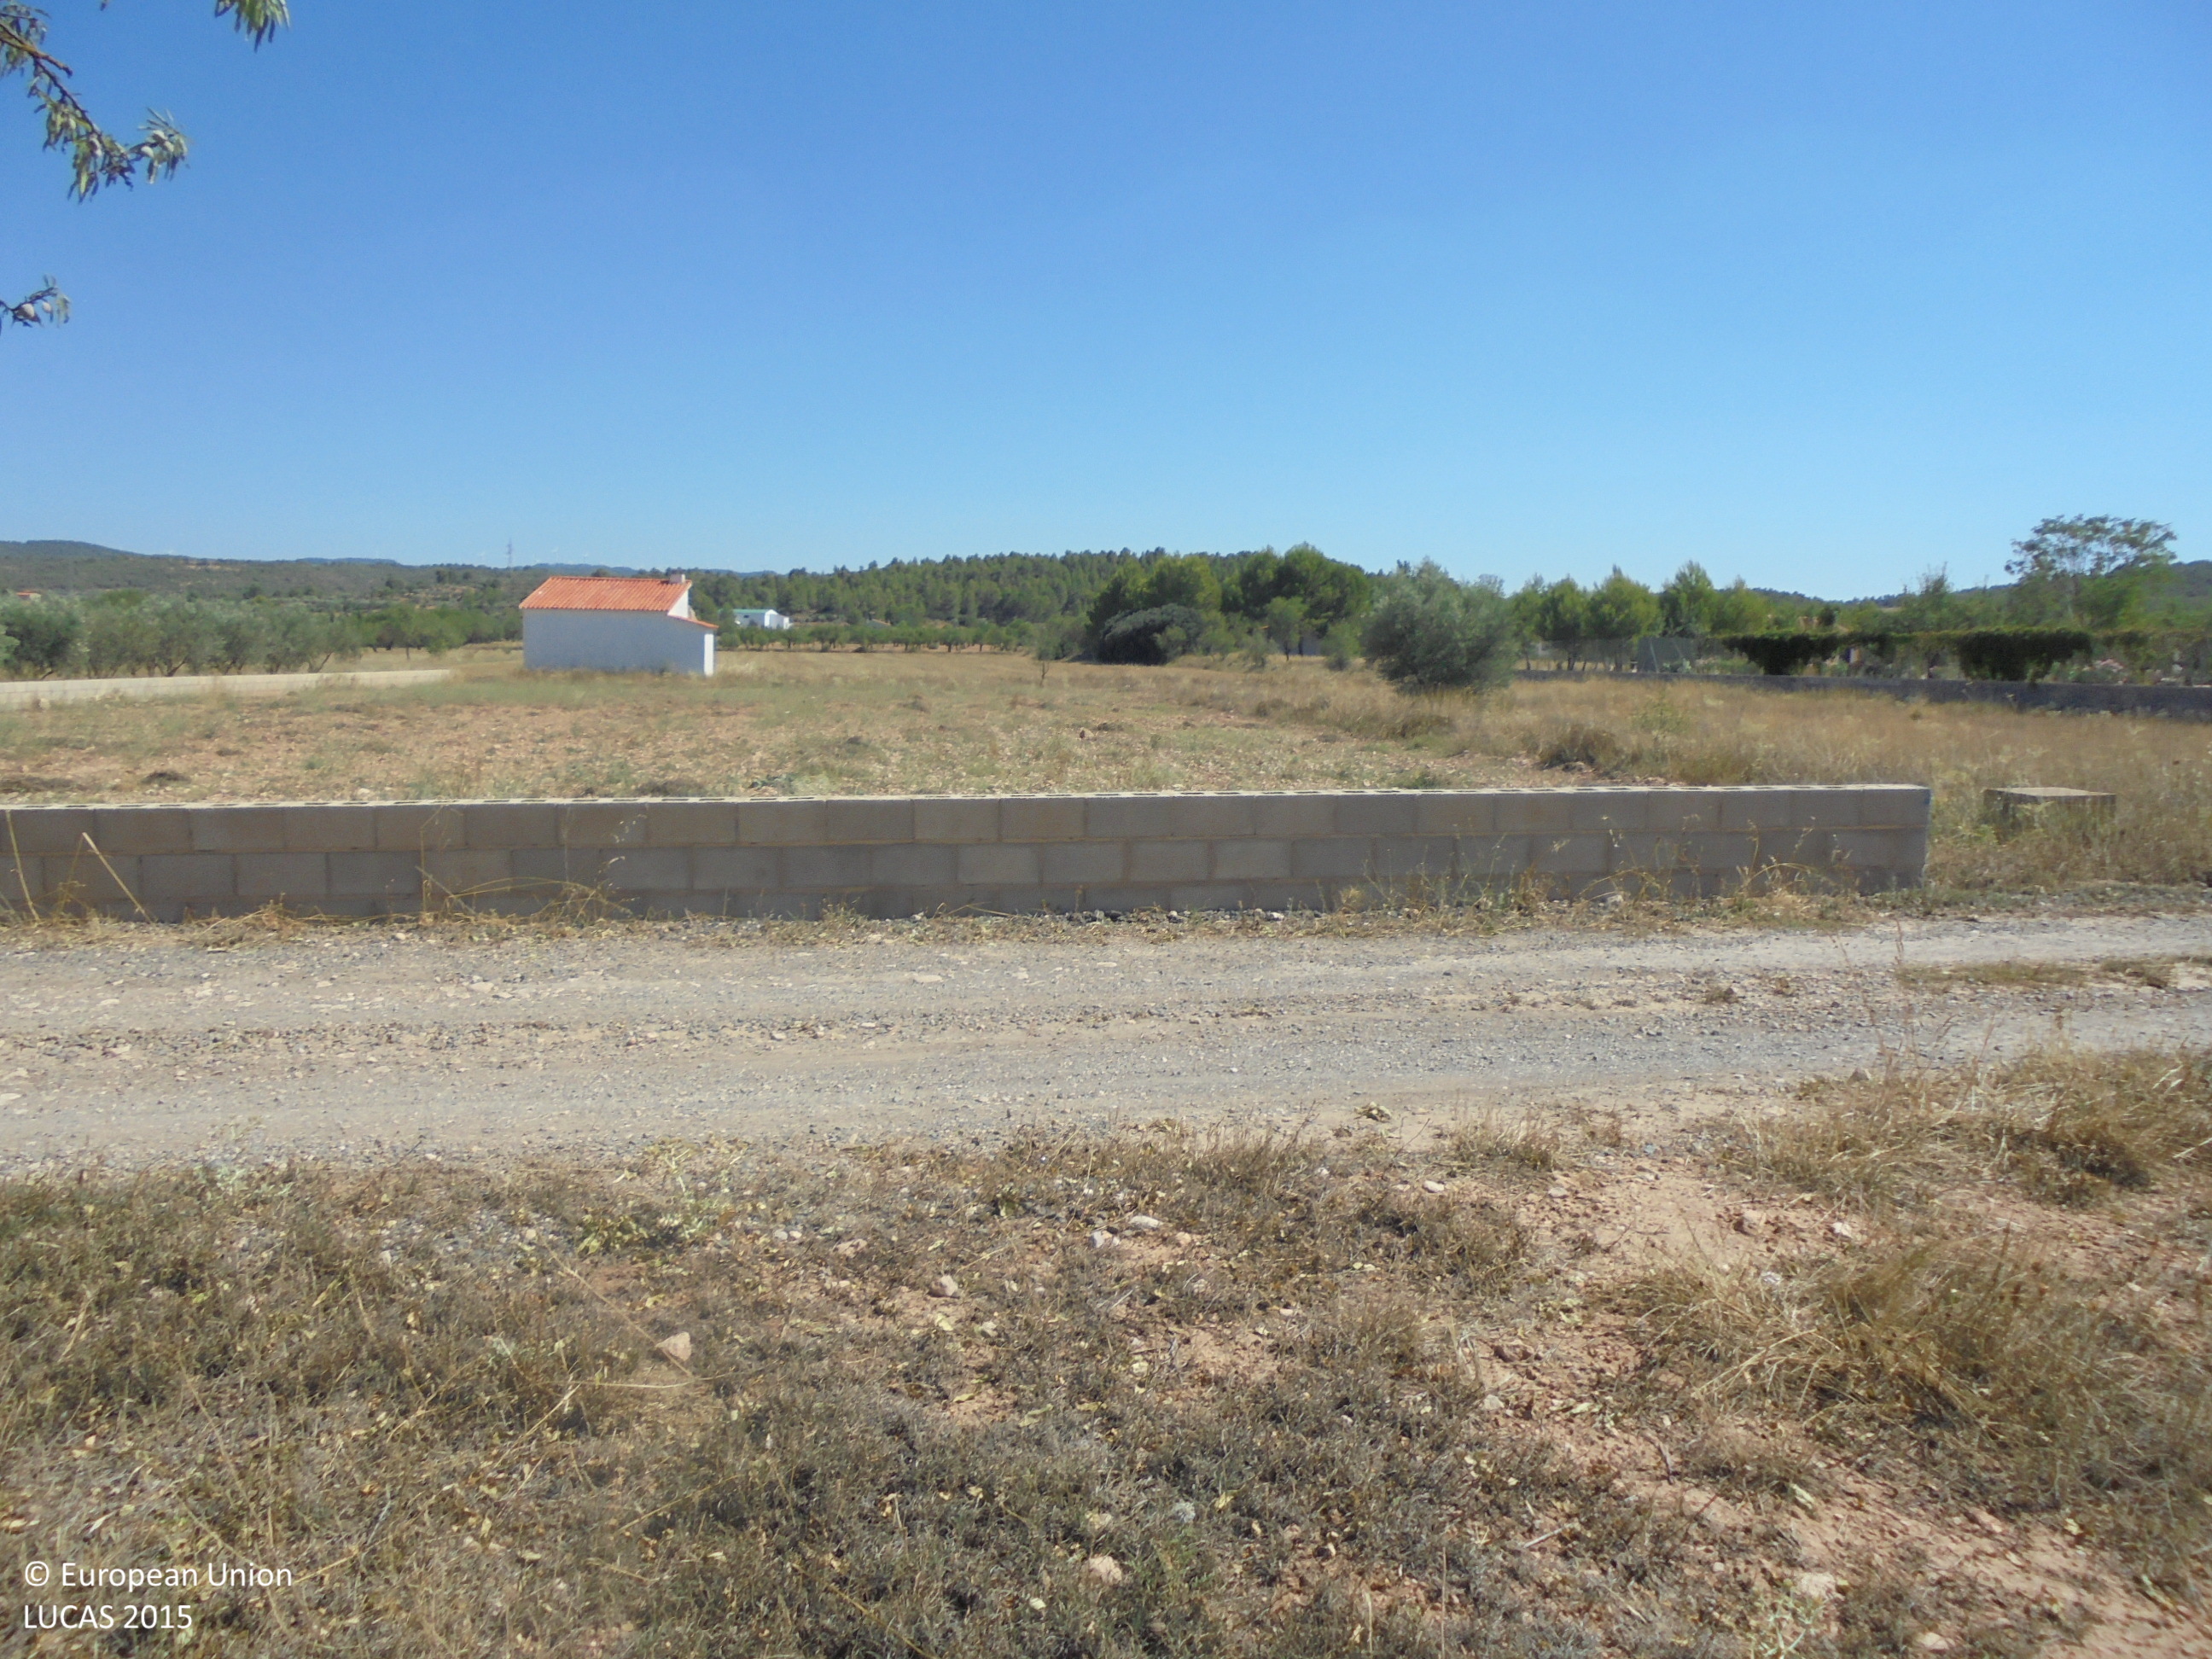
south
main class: Cropland
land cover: Nuts trees
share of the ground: 25 - 50 %
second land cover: Spontaneously vegetated surfaces
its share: 50 - 75 %
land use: Agriculture (excluding fallow land and kitchen gardens)
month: July
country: ES
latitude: 39.0385
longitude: -1.0521
